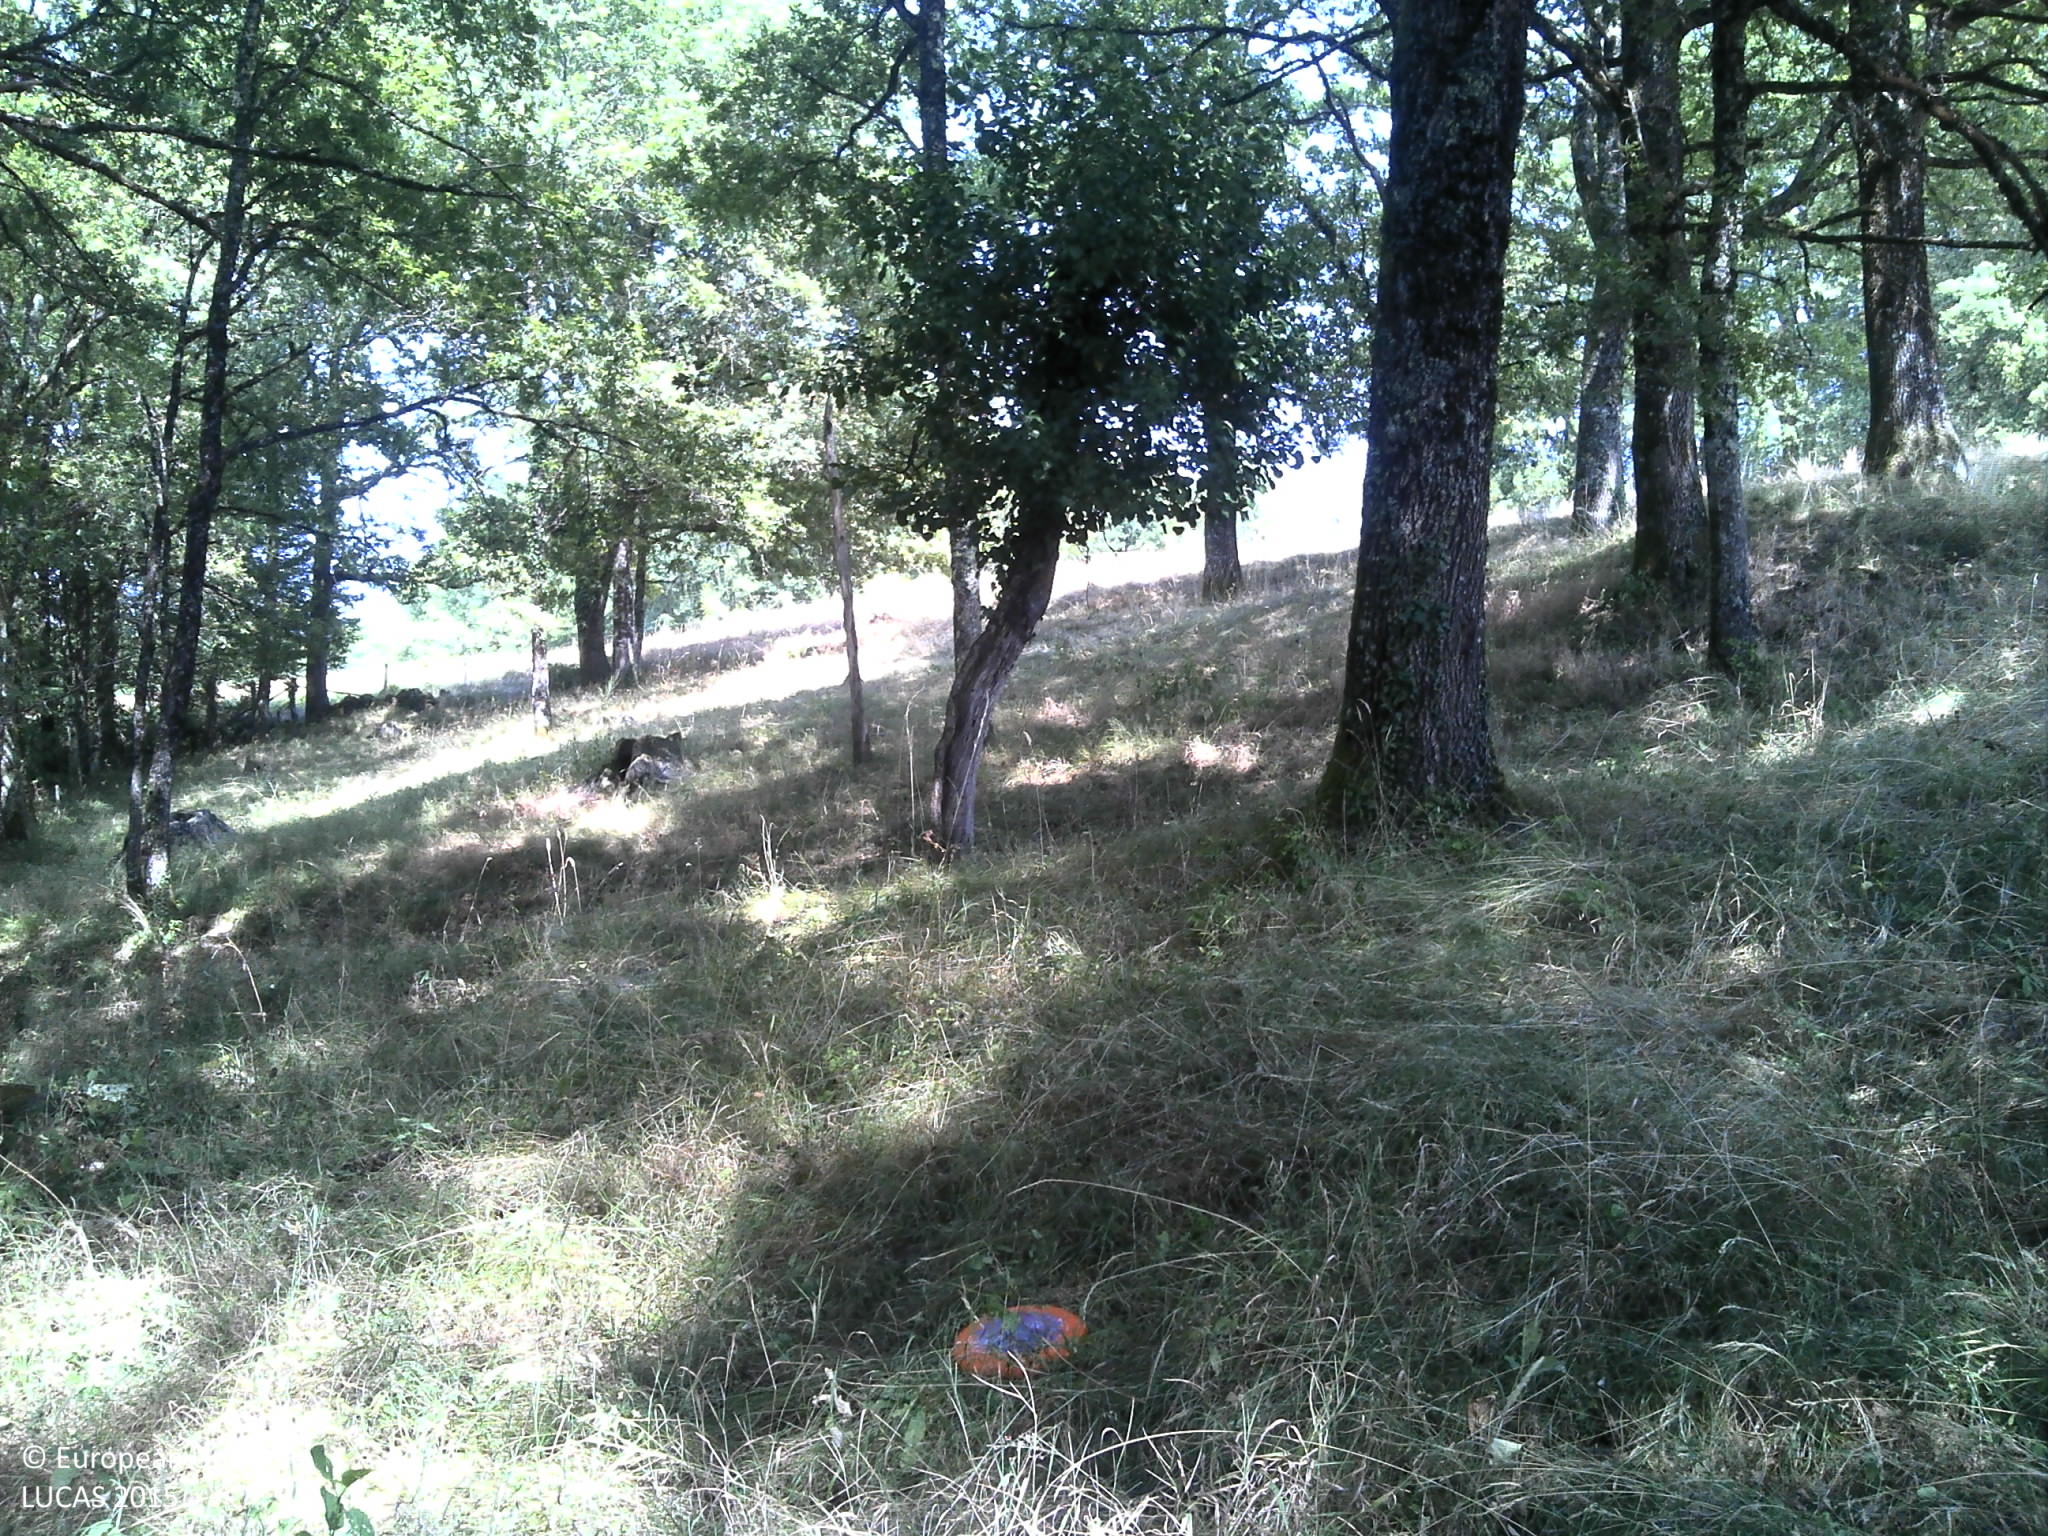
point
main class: Woodland
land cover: Broadleaved woodland
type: thermophilous deciduous forest
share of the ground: > 75 %
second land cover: Grassland without tree/shrub cover
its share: > 75 %
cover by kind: broadleaved forest trees 50 %, herbaceous plants 45 %, lichens and mosses 5 %
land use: Forestry
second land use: Agriculture (excluding fallow land and kitchen gardens)
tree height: > 5 m
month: July
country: FR
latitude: 45.0727
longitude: 1.7533
